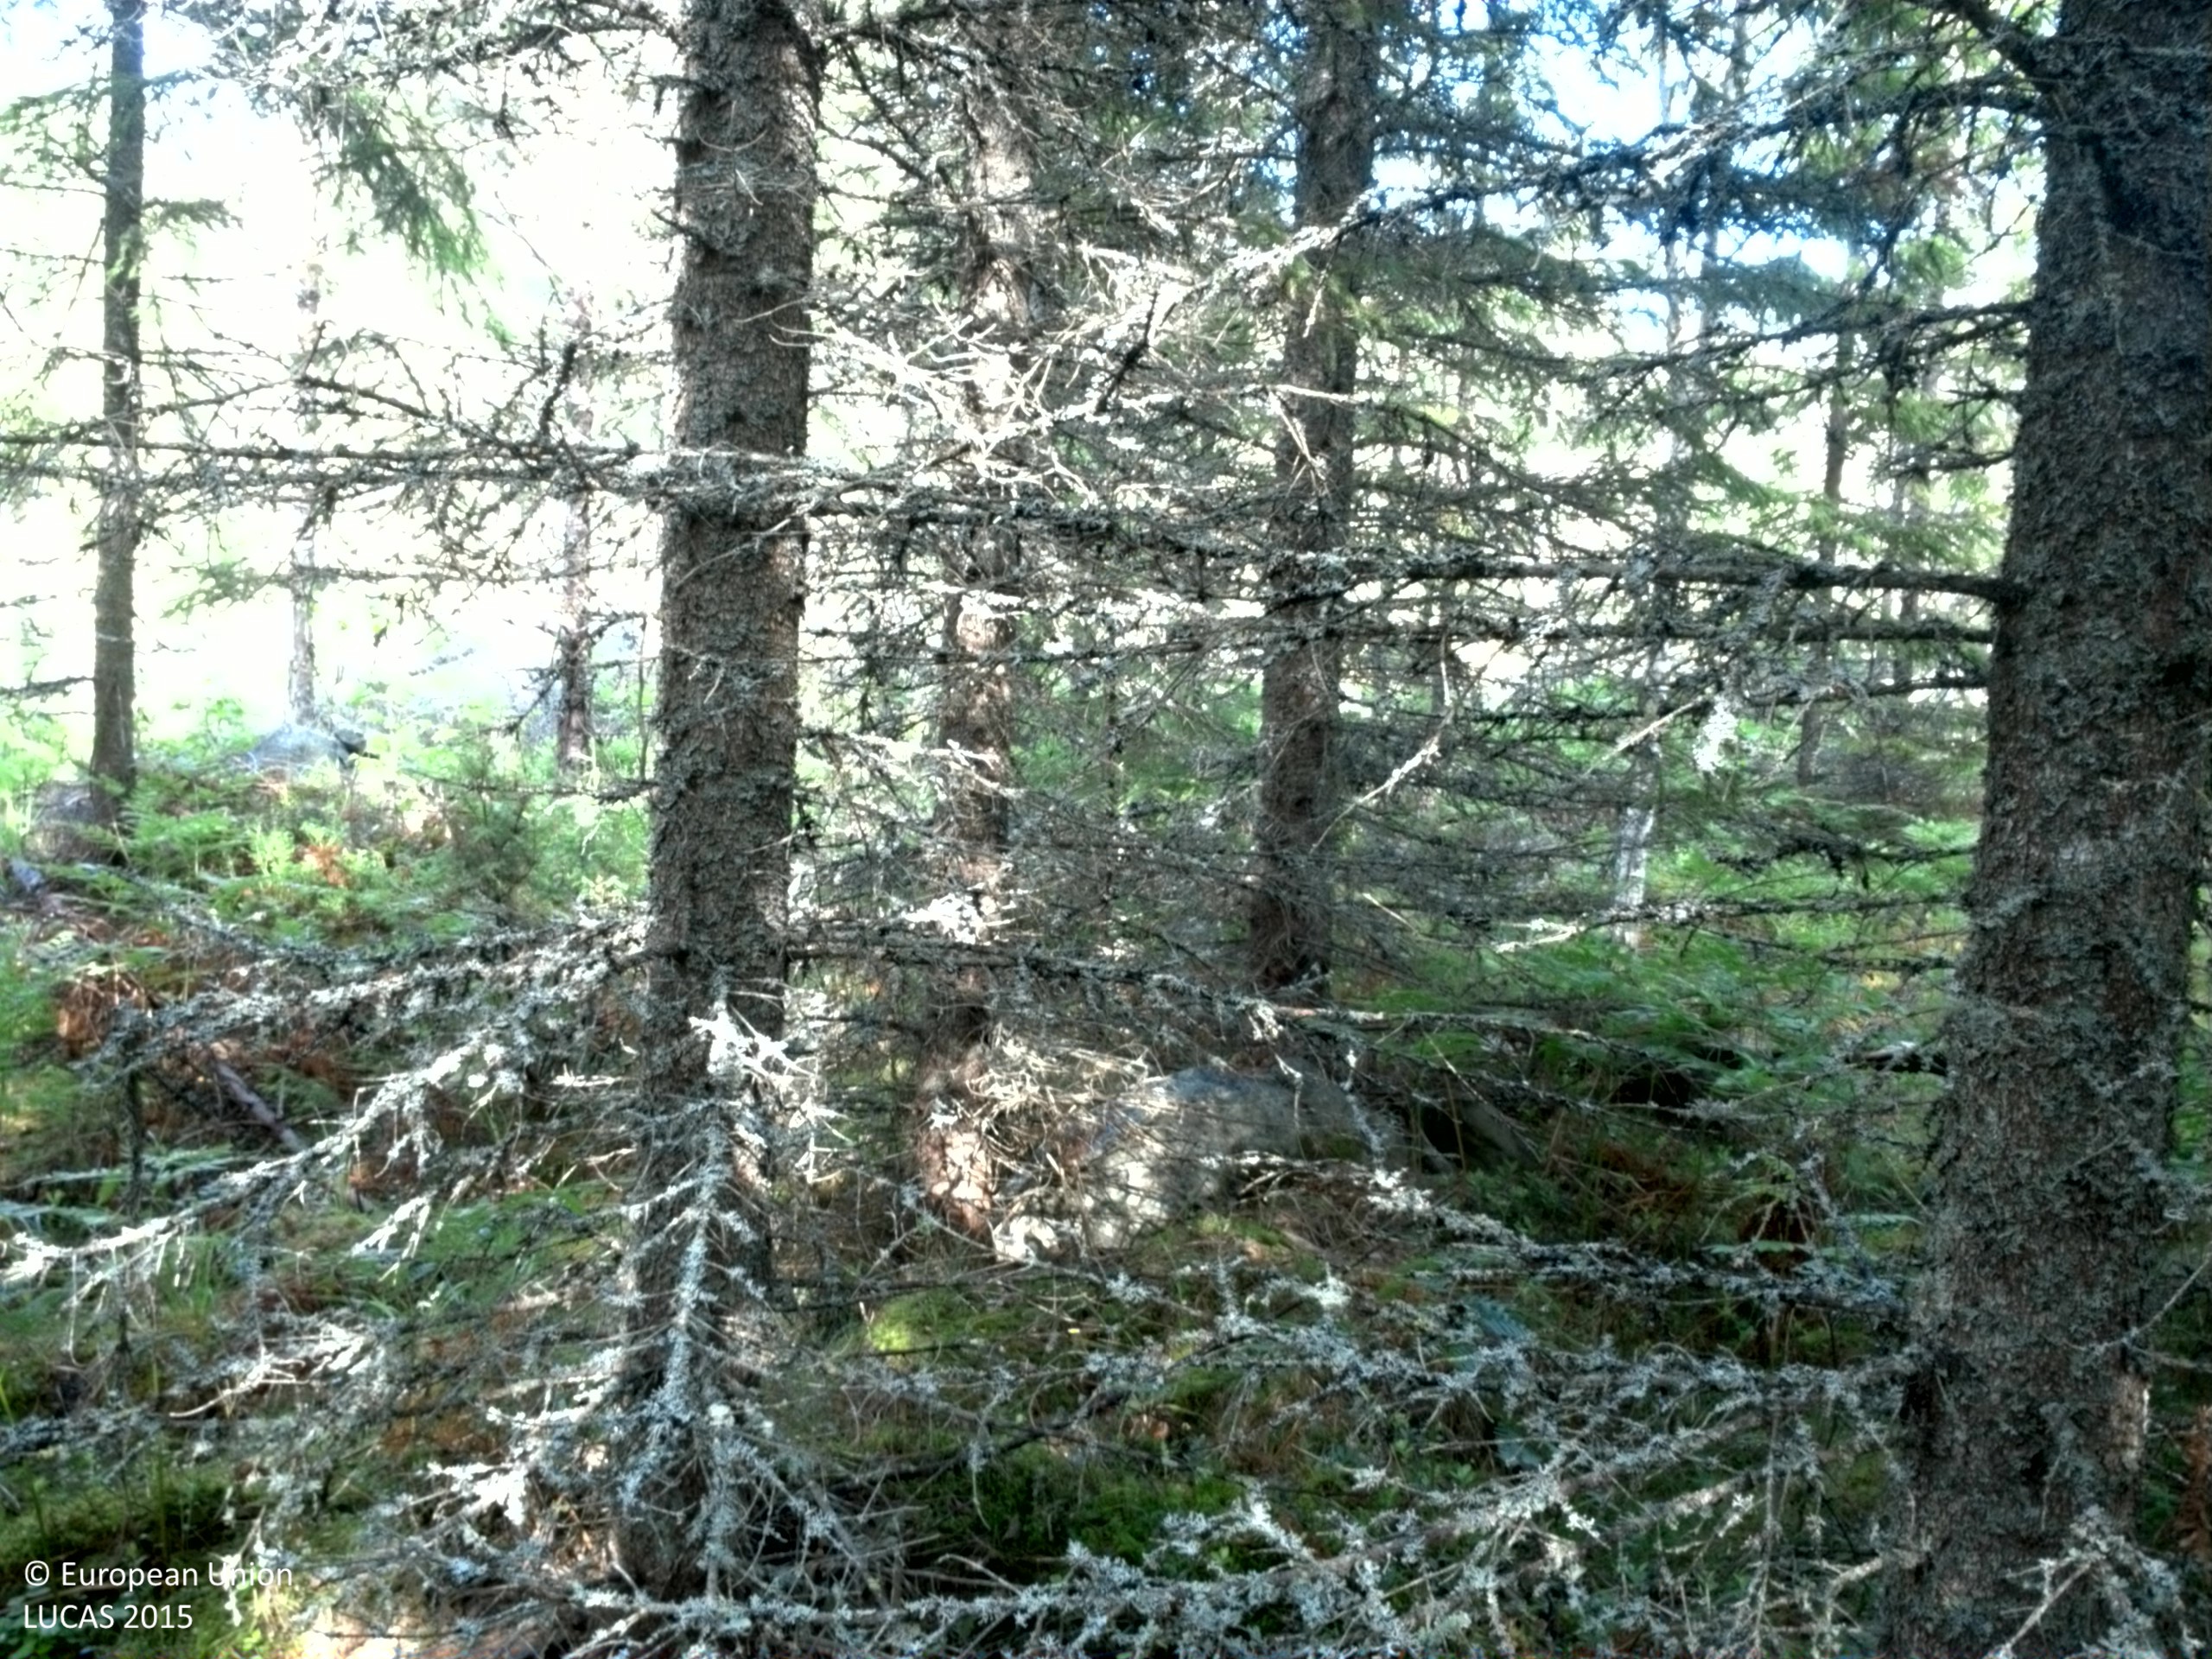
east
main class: Woodland
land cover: Spruce dominated coniferous woodland
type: boreal forest
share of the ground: > 75 %
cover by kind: coniferous forest trees 75 %, shrubs 10 %, lichens and mosses 10 %, herbaceous plants 5 %
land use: Forestry
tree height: > 5 m
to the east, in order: Spruce dominated coniferous woodland; Shrubland with sparse tree cover; Electric lines; Shrubland with sparse tree cover; Other coniferous woodland; Spruce dominated coniferous woodland
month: June
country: SE
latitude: 60.3704
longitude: 17.6624
